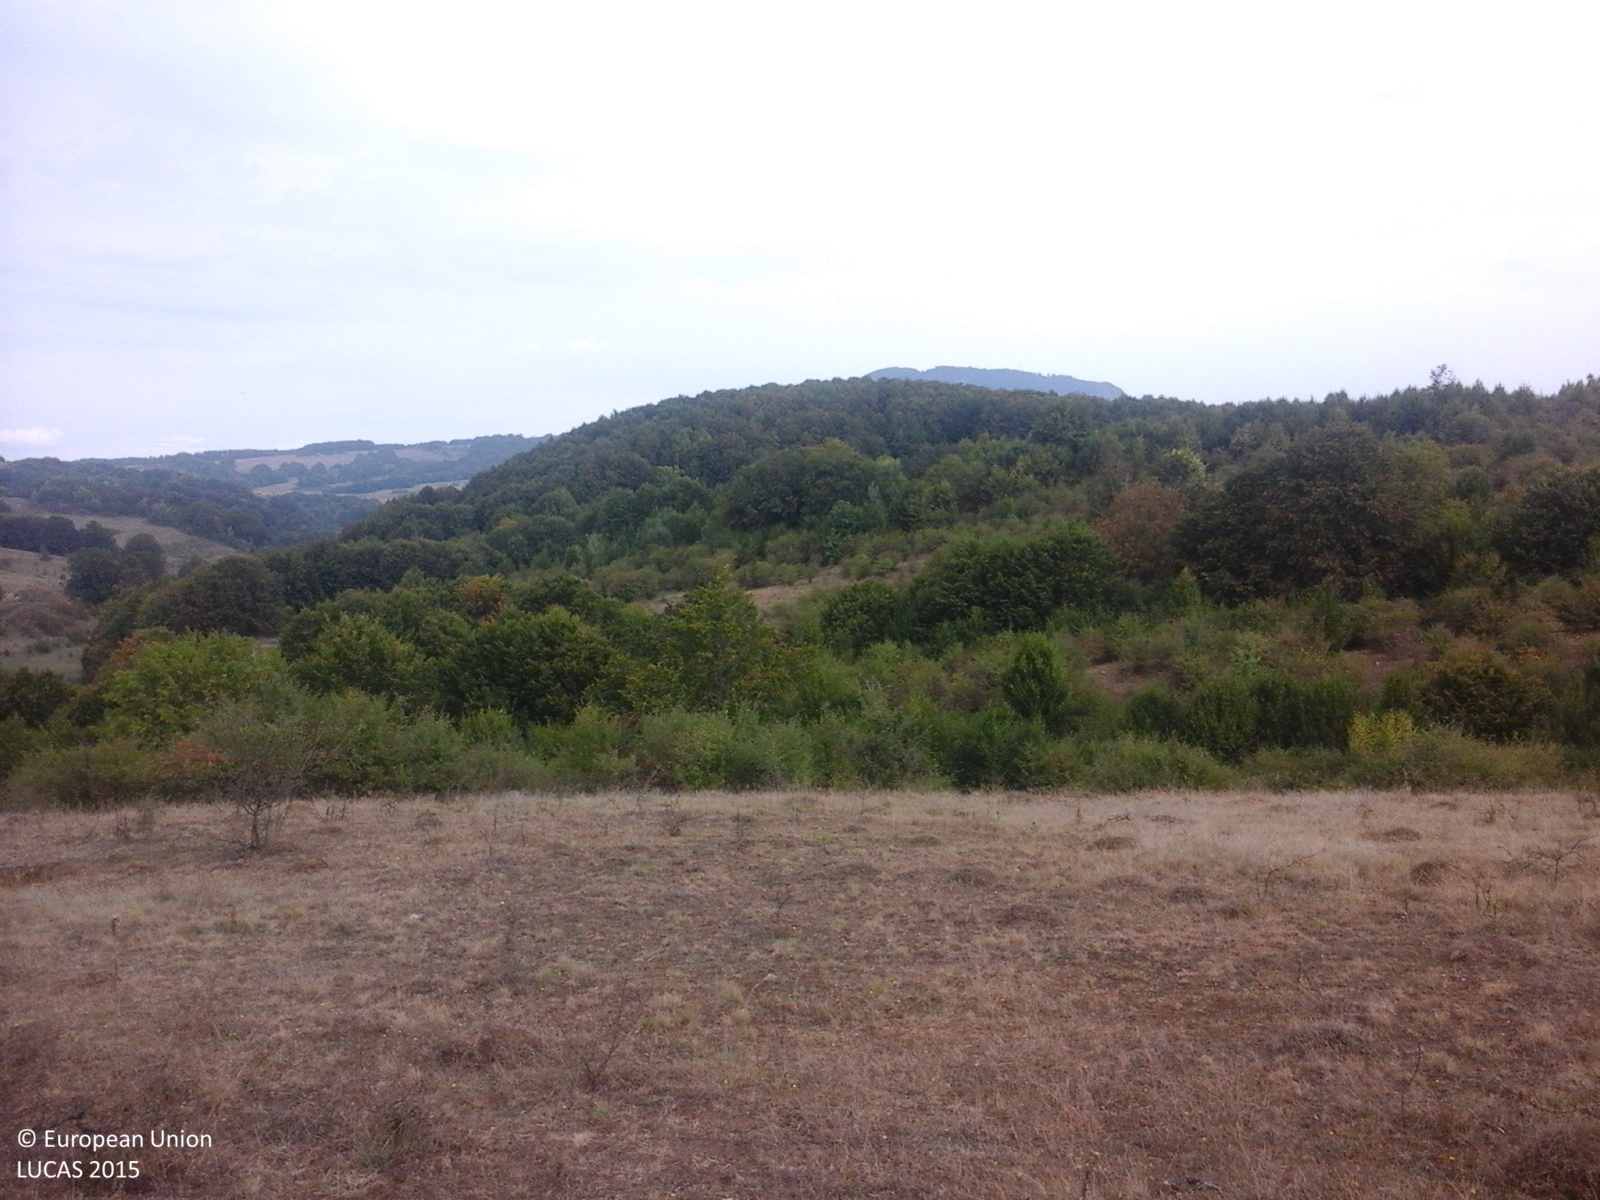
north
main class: Grassland
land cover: Grassland with sparse tree/shrub cover
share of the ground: > 75 %
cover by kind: herbaceous plants 90 %, broadleaved forest trees 5 %, shrubs 5 %
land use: Agriculture (excluding fallow land and kitchen gardens)
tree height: < 5 m
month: September
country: RO
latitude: 47.5085
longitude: 23.8490
